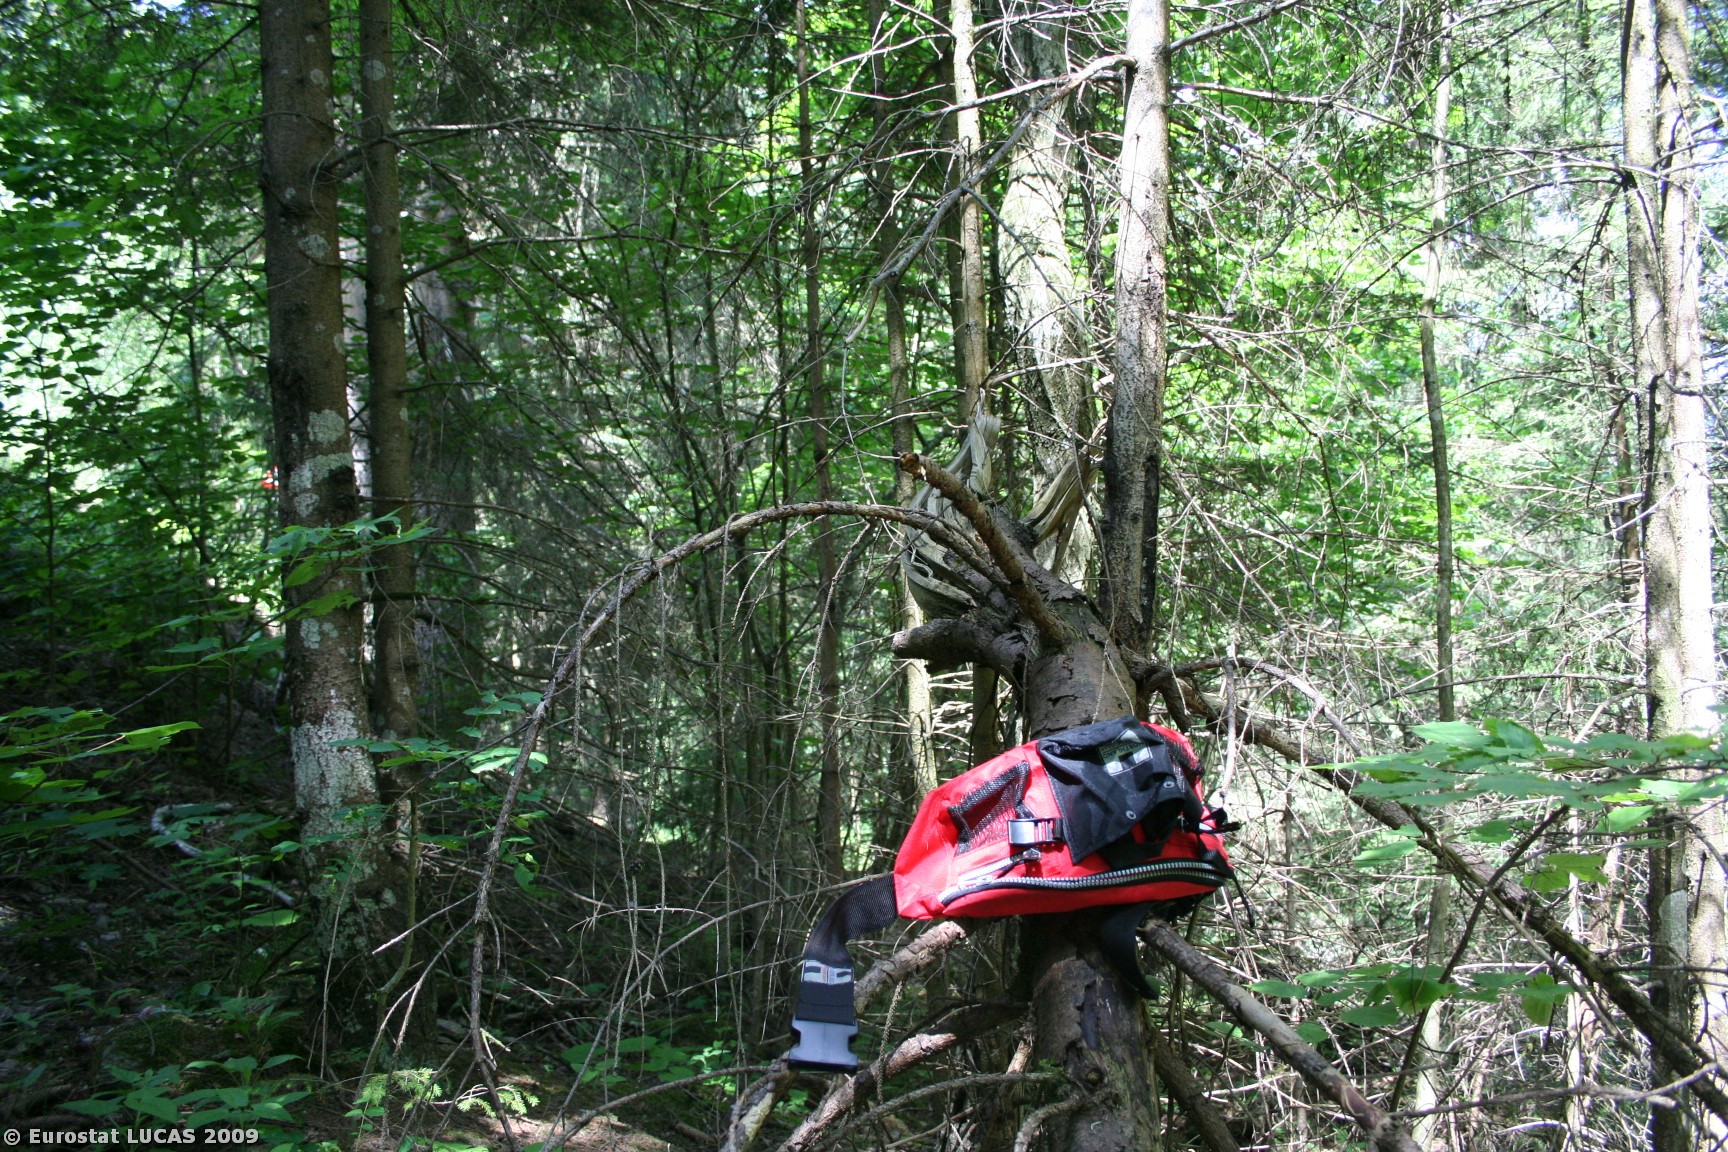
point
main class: Woodland
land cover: Coniferous woodland
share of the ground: 50 - 75 %
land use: Forestry
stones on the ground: < 10 %
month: June
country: AT
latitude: 47.2896
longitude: 11.8628
